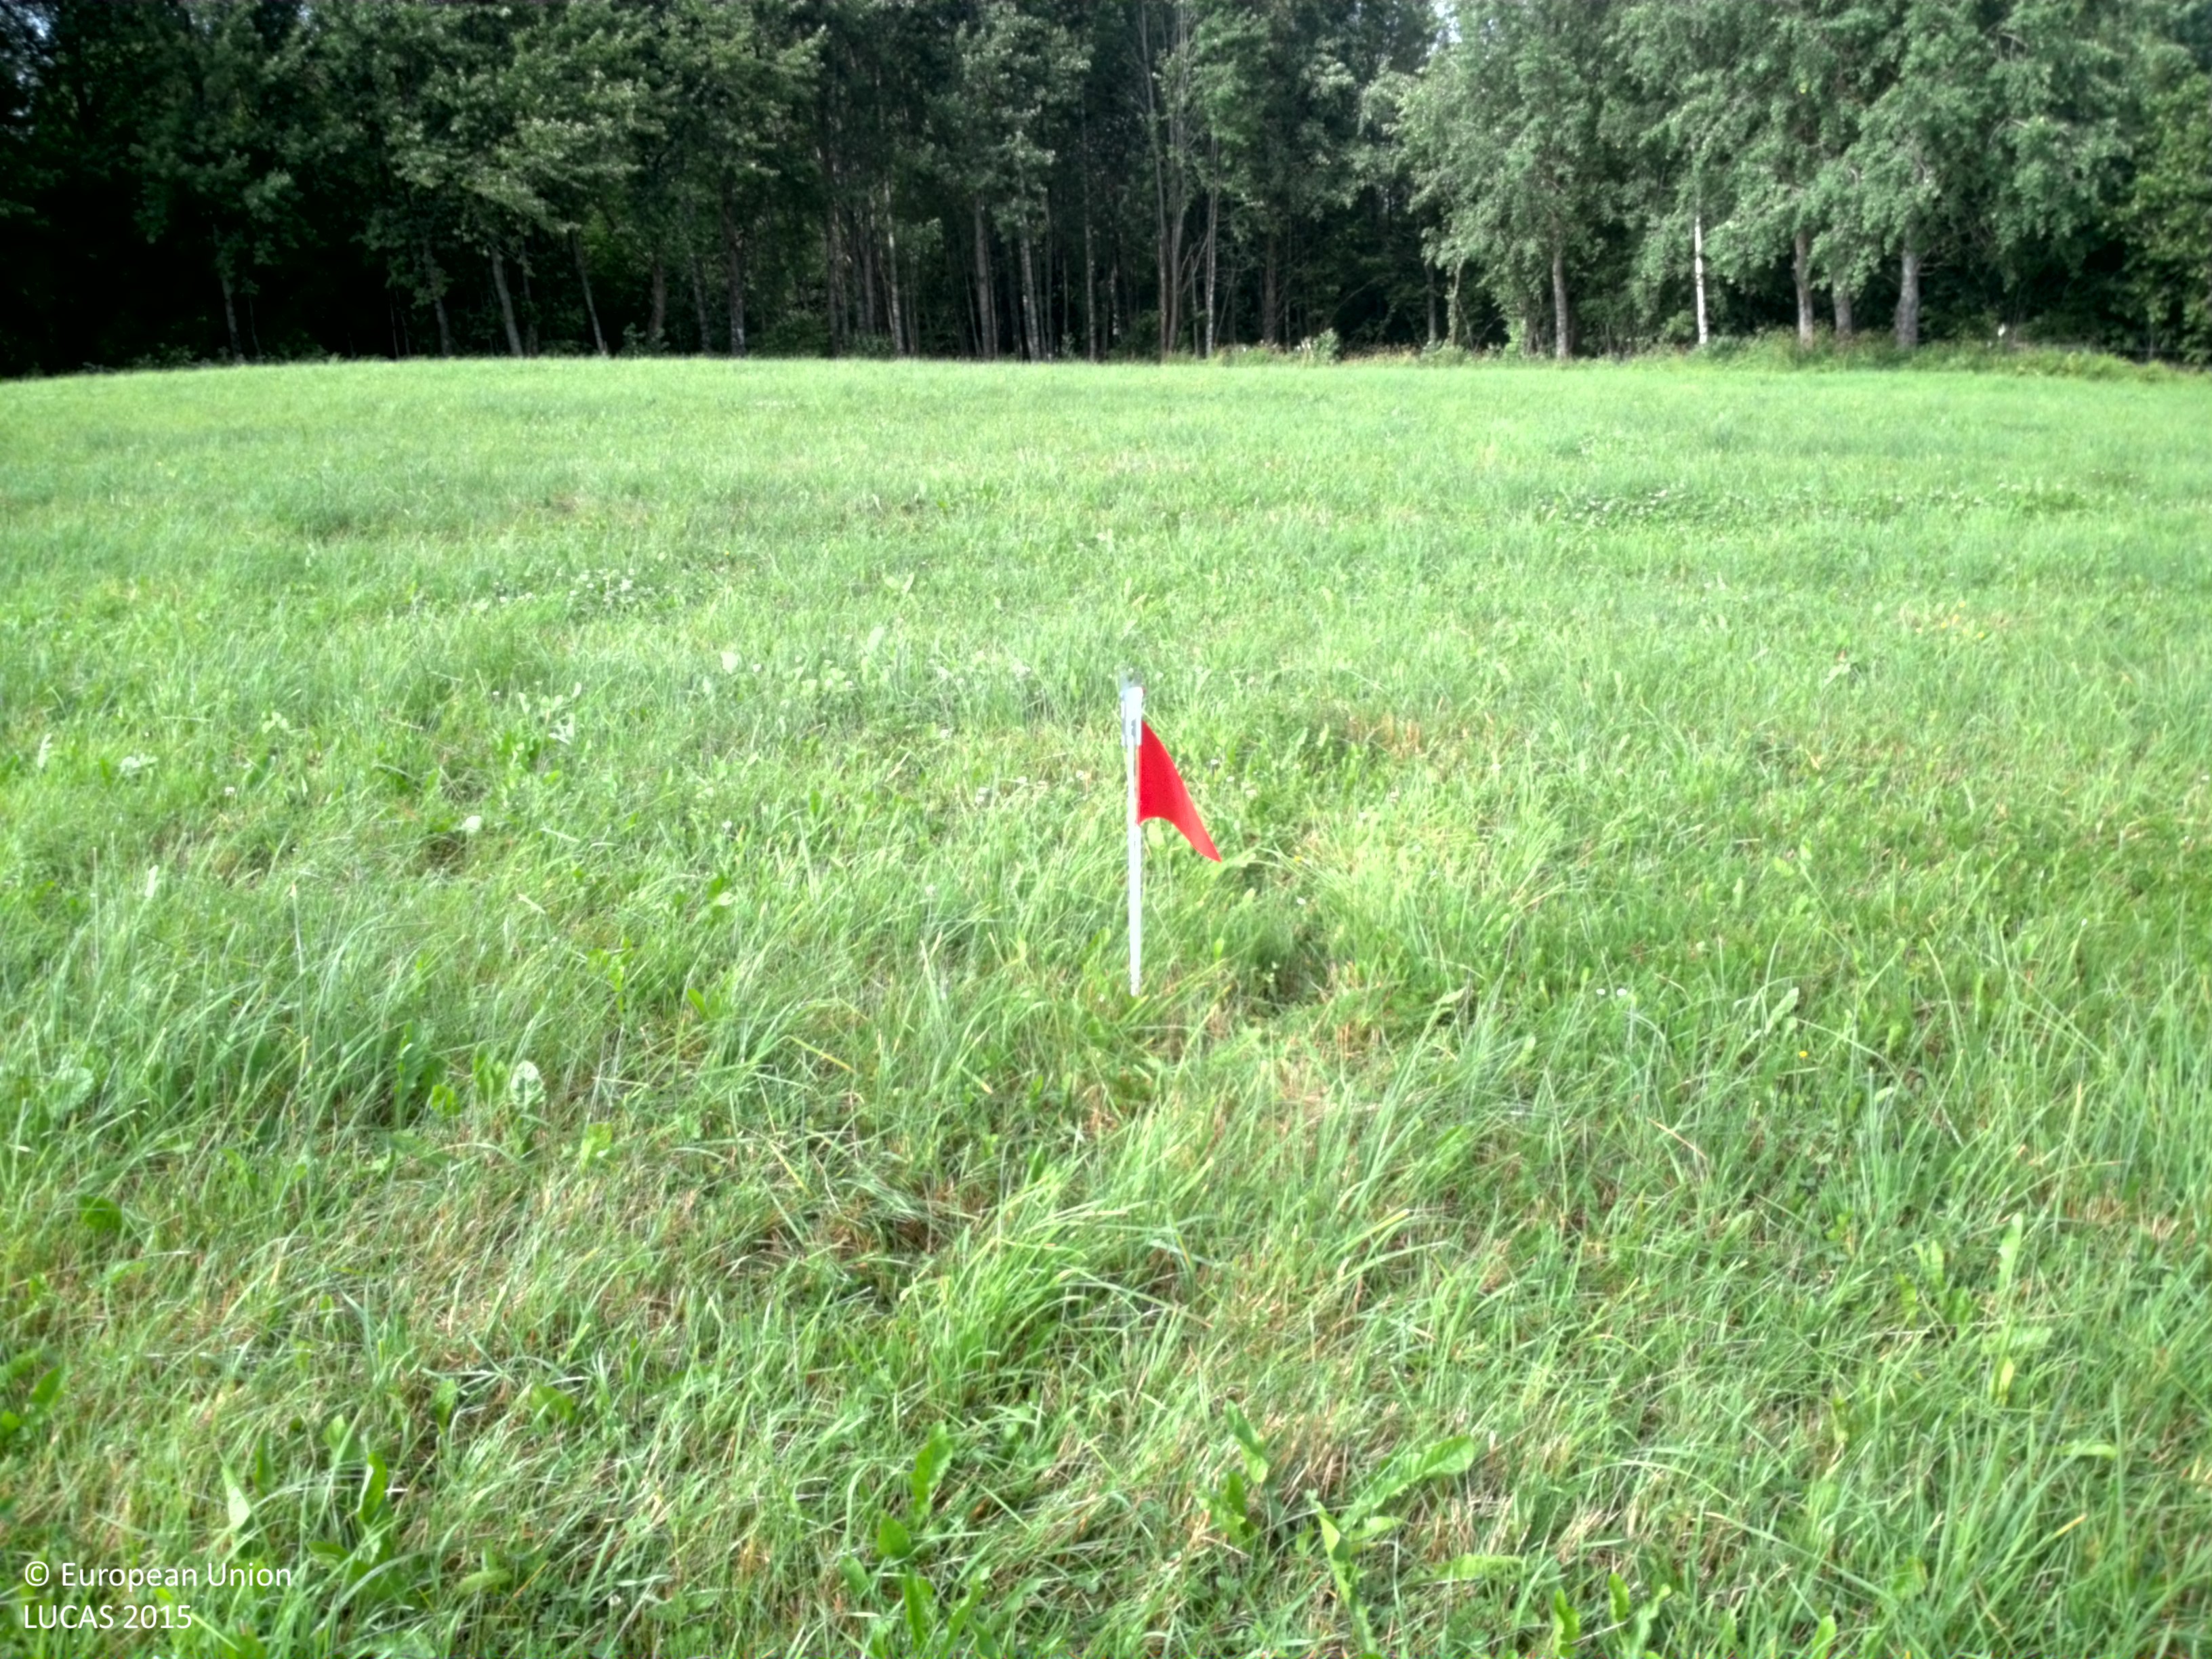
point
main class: Grassland
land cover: Grassland without tree/shrub cover
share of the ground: > 75 %
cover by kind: herbaceous plants 100 %
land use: Agriculture (excluding fallow land and kitchen gardens)
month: July
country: SE
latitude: 57.7763
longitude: 14.7201
